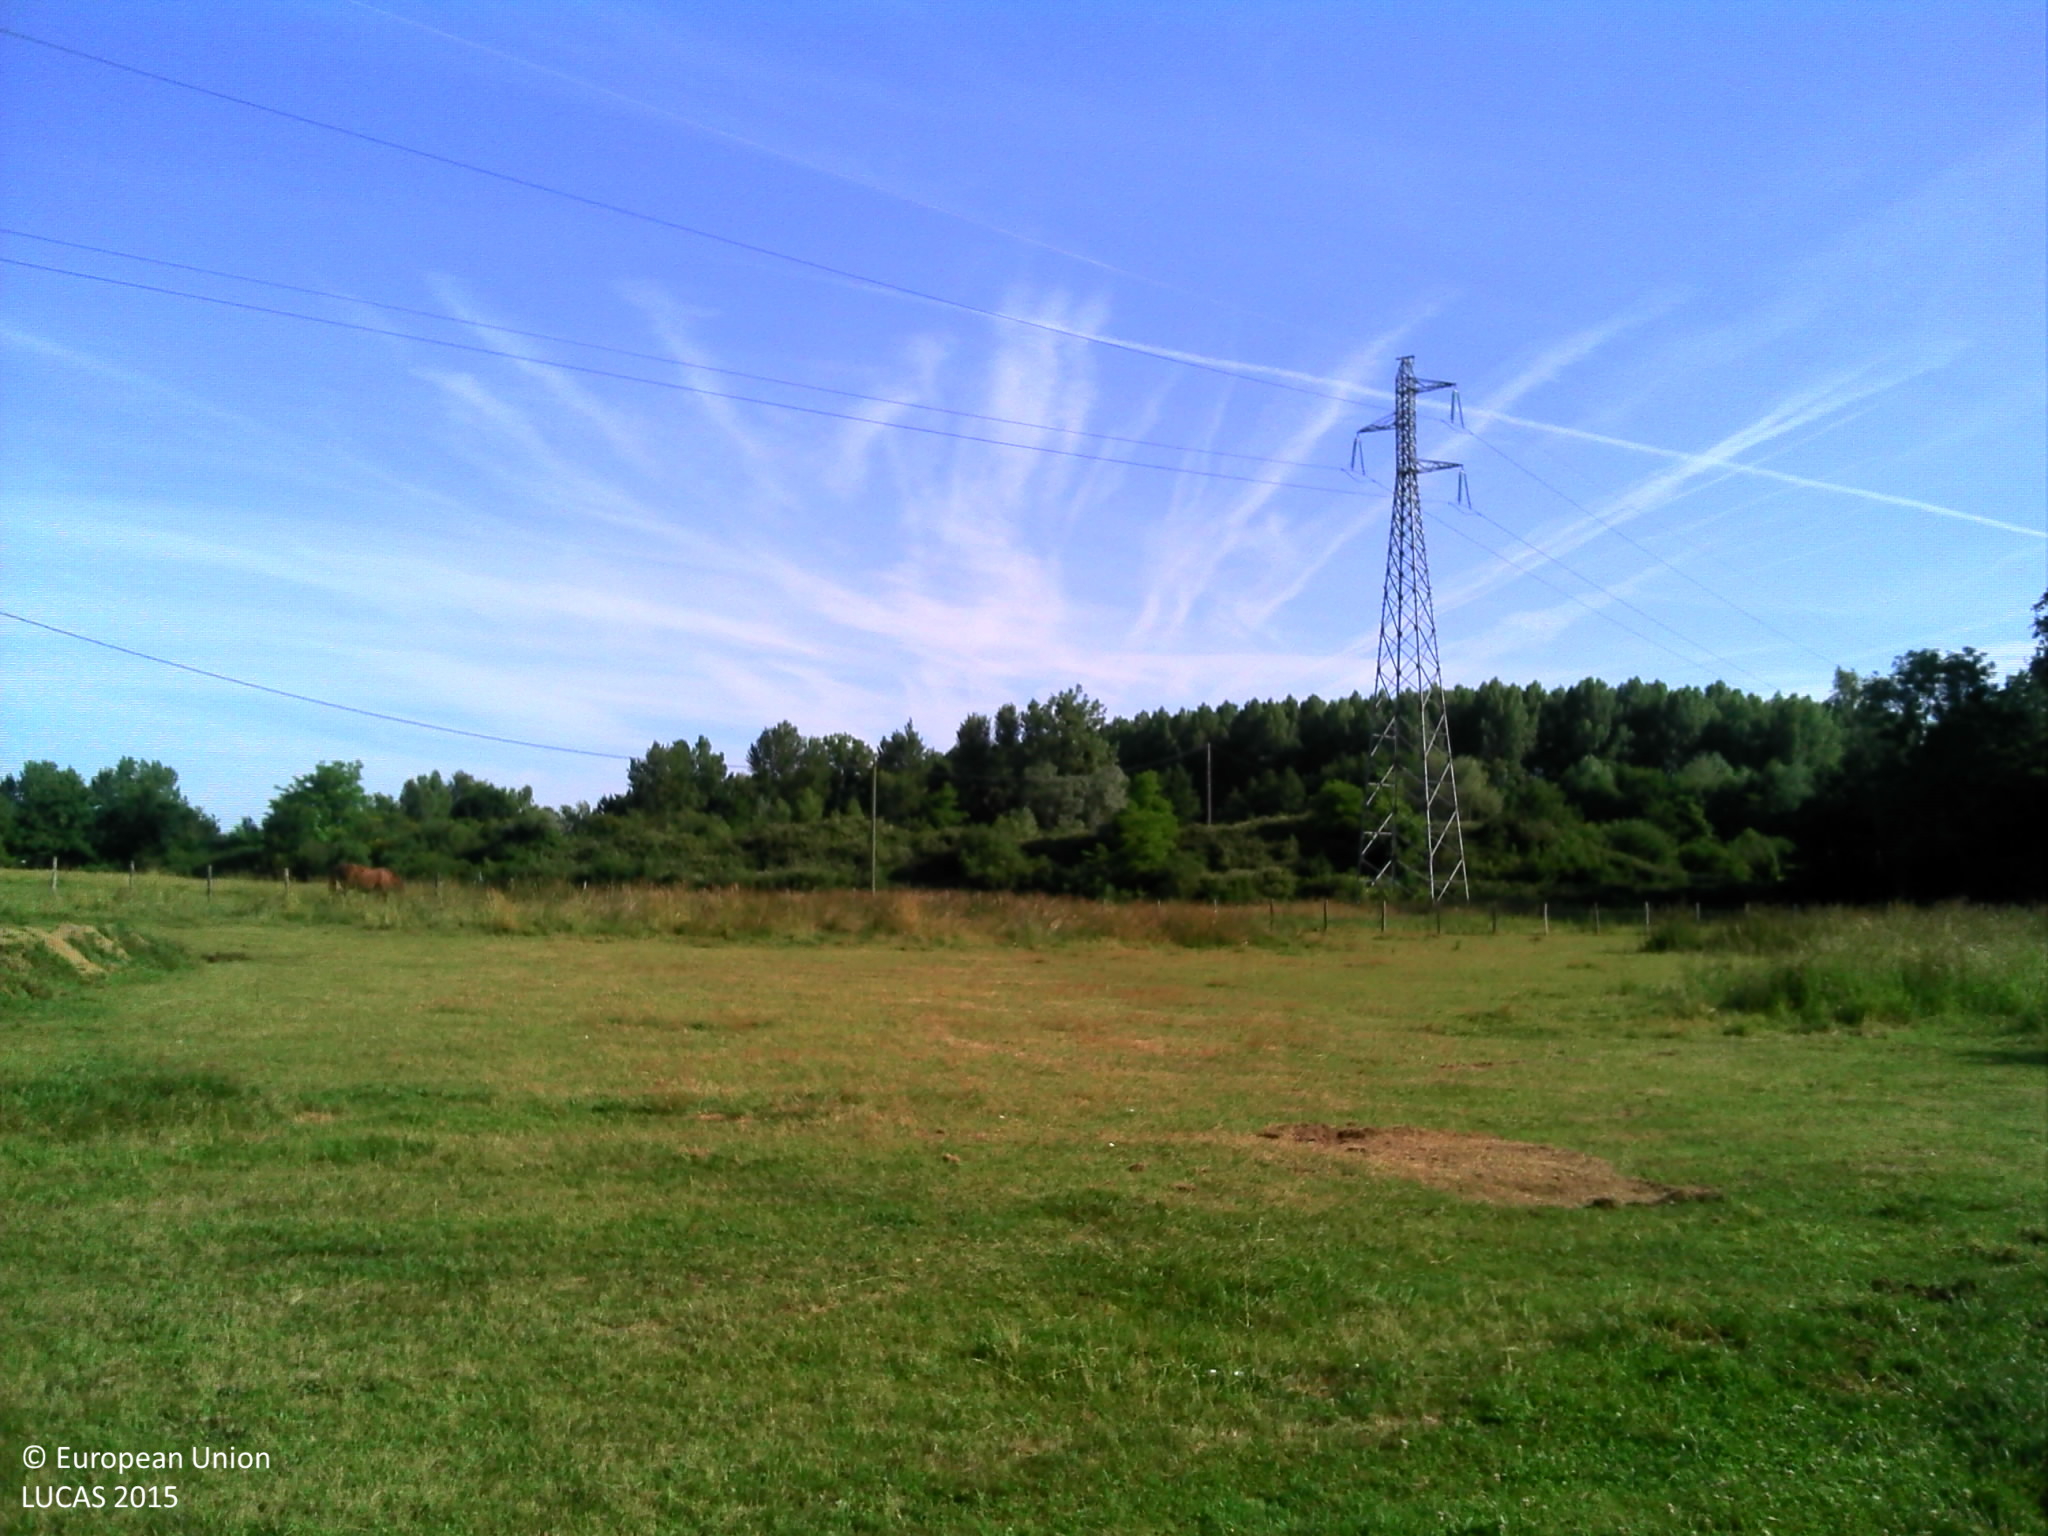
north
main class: Grassland
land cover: Grassland without tree/shrub cover
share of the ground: > 75 %
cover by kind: herbaceous plants 100 %
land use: Agriculture (excluding fallow land and kitchen gardens)
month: June
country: FR
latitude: 48.0488
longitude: 0.3024
